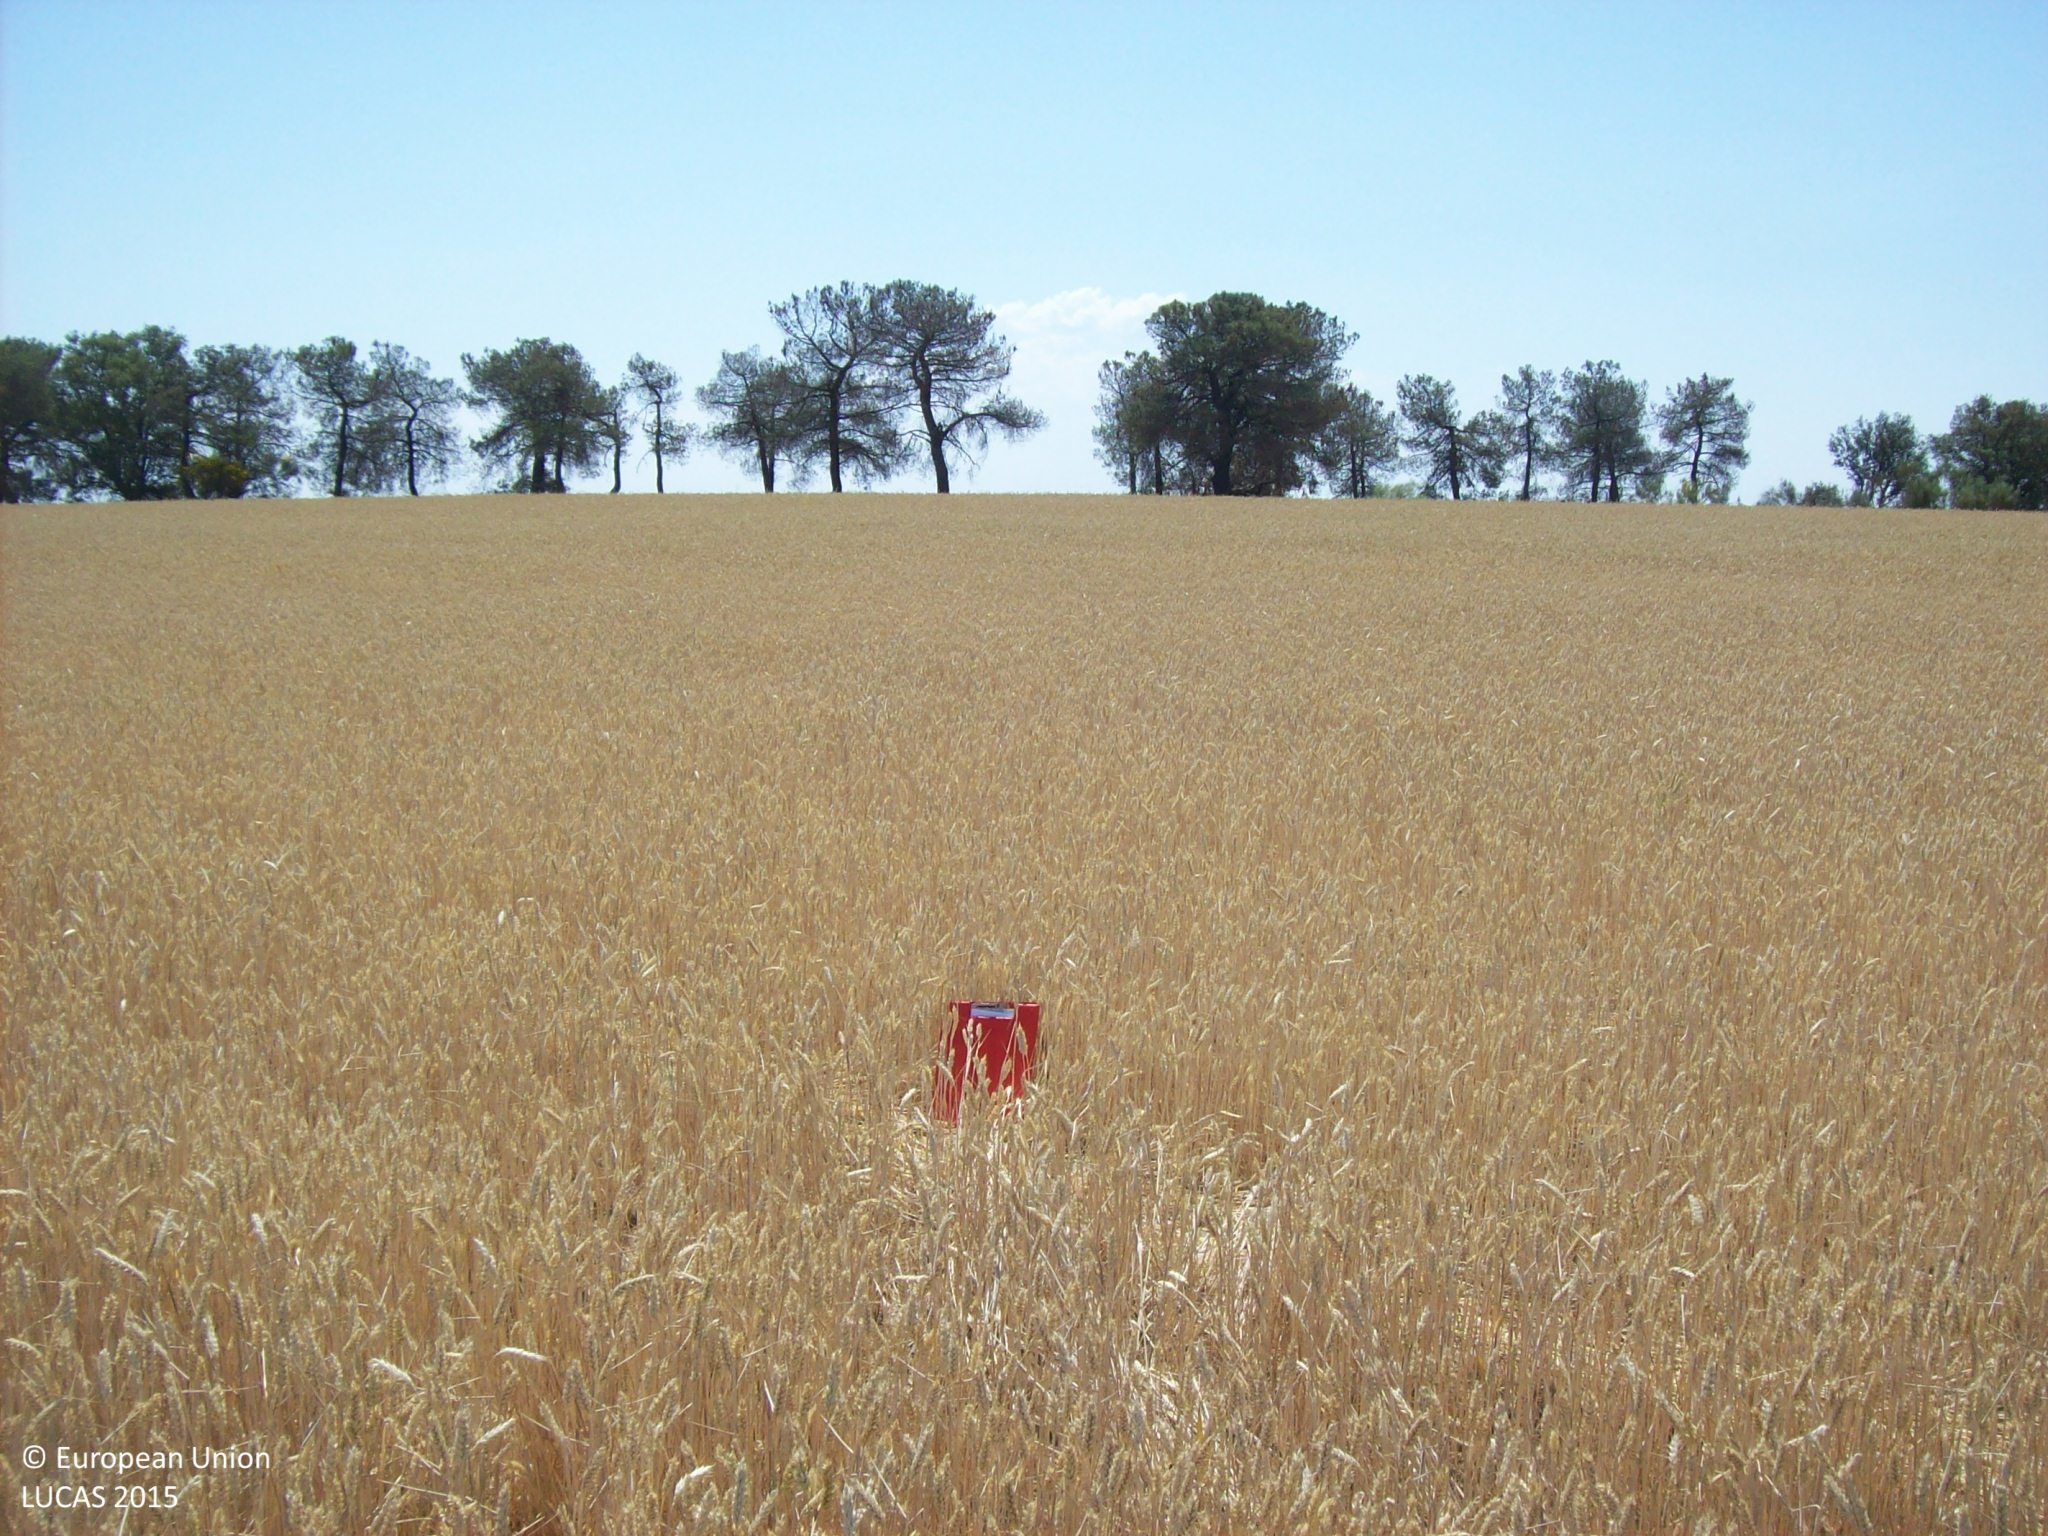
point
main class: Cropland
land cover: Common wheat
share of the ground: > 75 %
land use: Agriculture (excluding fallow land and kitchen gardens)
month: June
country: ES
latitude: 41.1910
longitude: -5.0561
